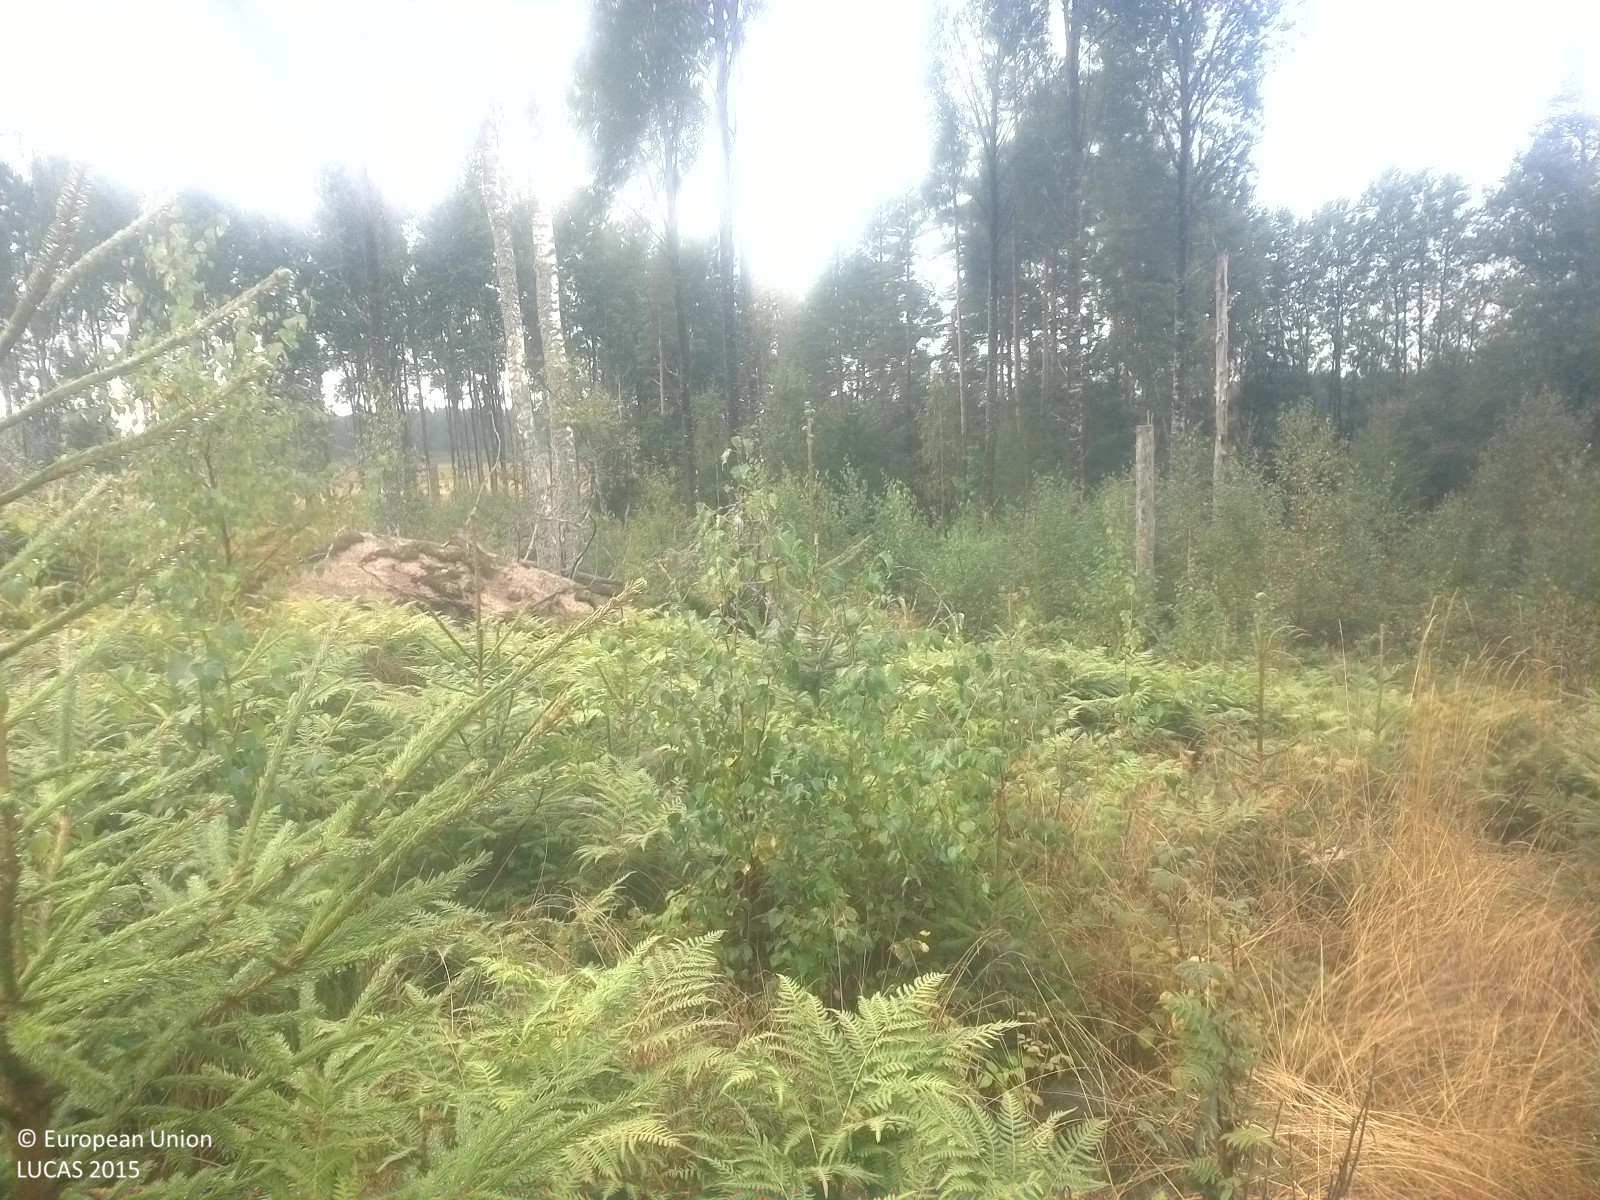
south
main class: Woodland
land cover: Spruce dominated mixed woodland
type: boreal forest
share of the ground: 25 - 50 %
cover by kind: herbaceous plants 35 %, coniferous forest trees 20 %, broadleaved forest trees 20 %, shrubs 10 %, lichens and mosses 10 %, consolidated bare surface 5 %
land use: Forestry
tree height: < 5 m
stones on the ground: 25 - 50 %
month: September
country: SE
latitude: 59.3626
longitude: 15.6742
